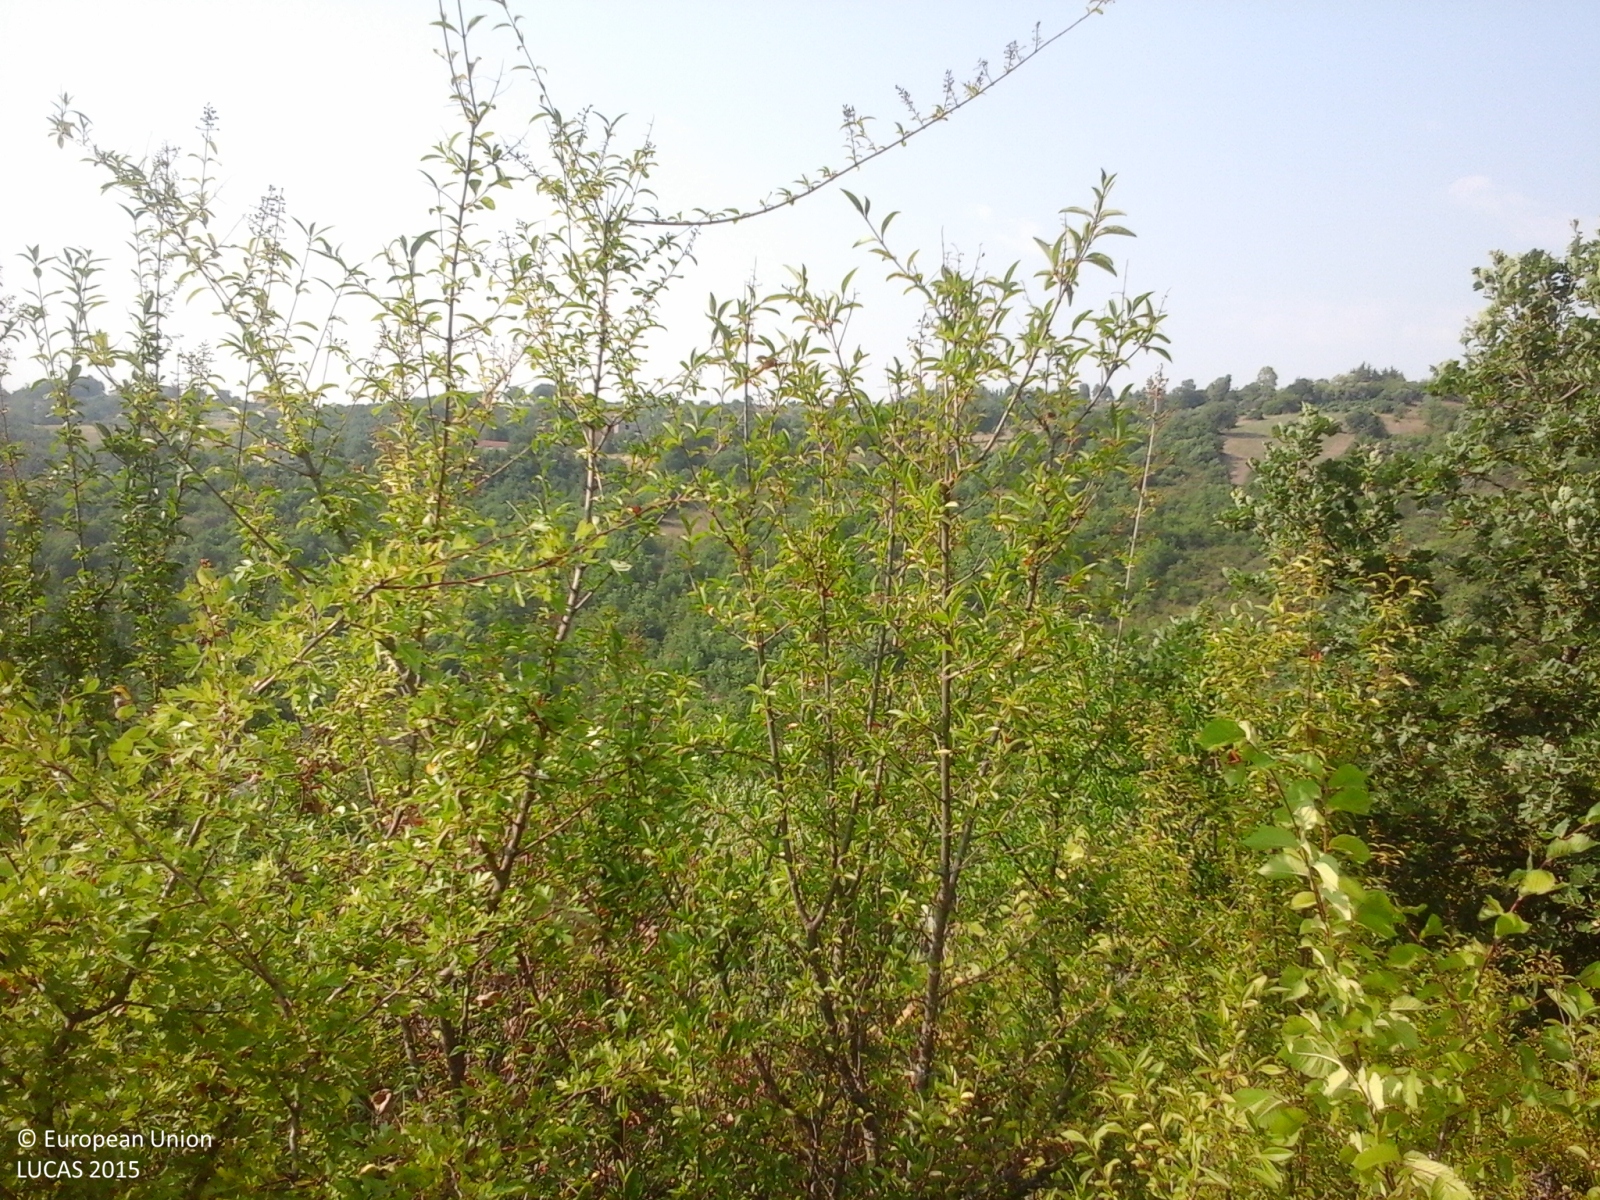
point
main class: Woodland
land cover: Broadleaved woodland
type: thermophilous deciduous forest
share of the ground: > 75 %
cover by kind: broadleaved forest trees 70 %, shrubs 25 %, herbaceous plants 5 %
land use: Forestry
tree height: > 5 m
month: July
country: IT
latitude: 40.8974
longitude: 15.0725
